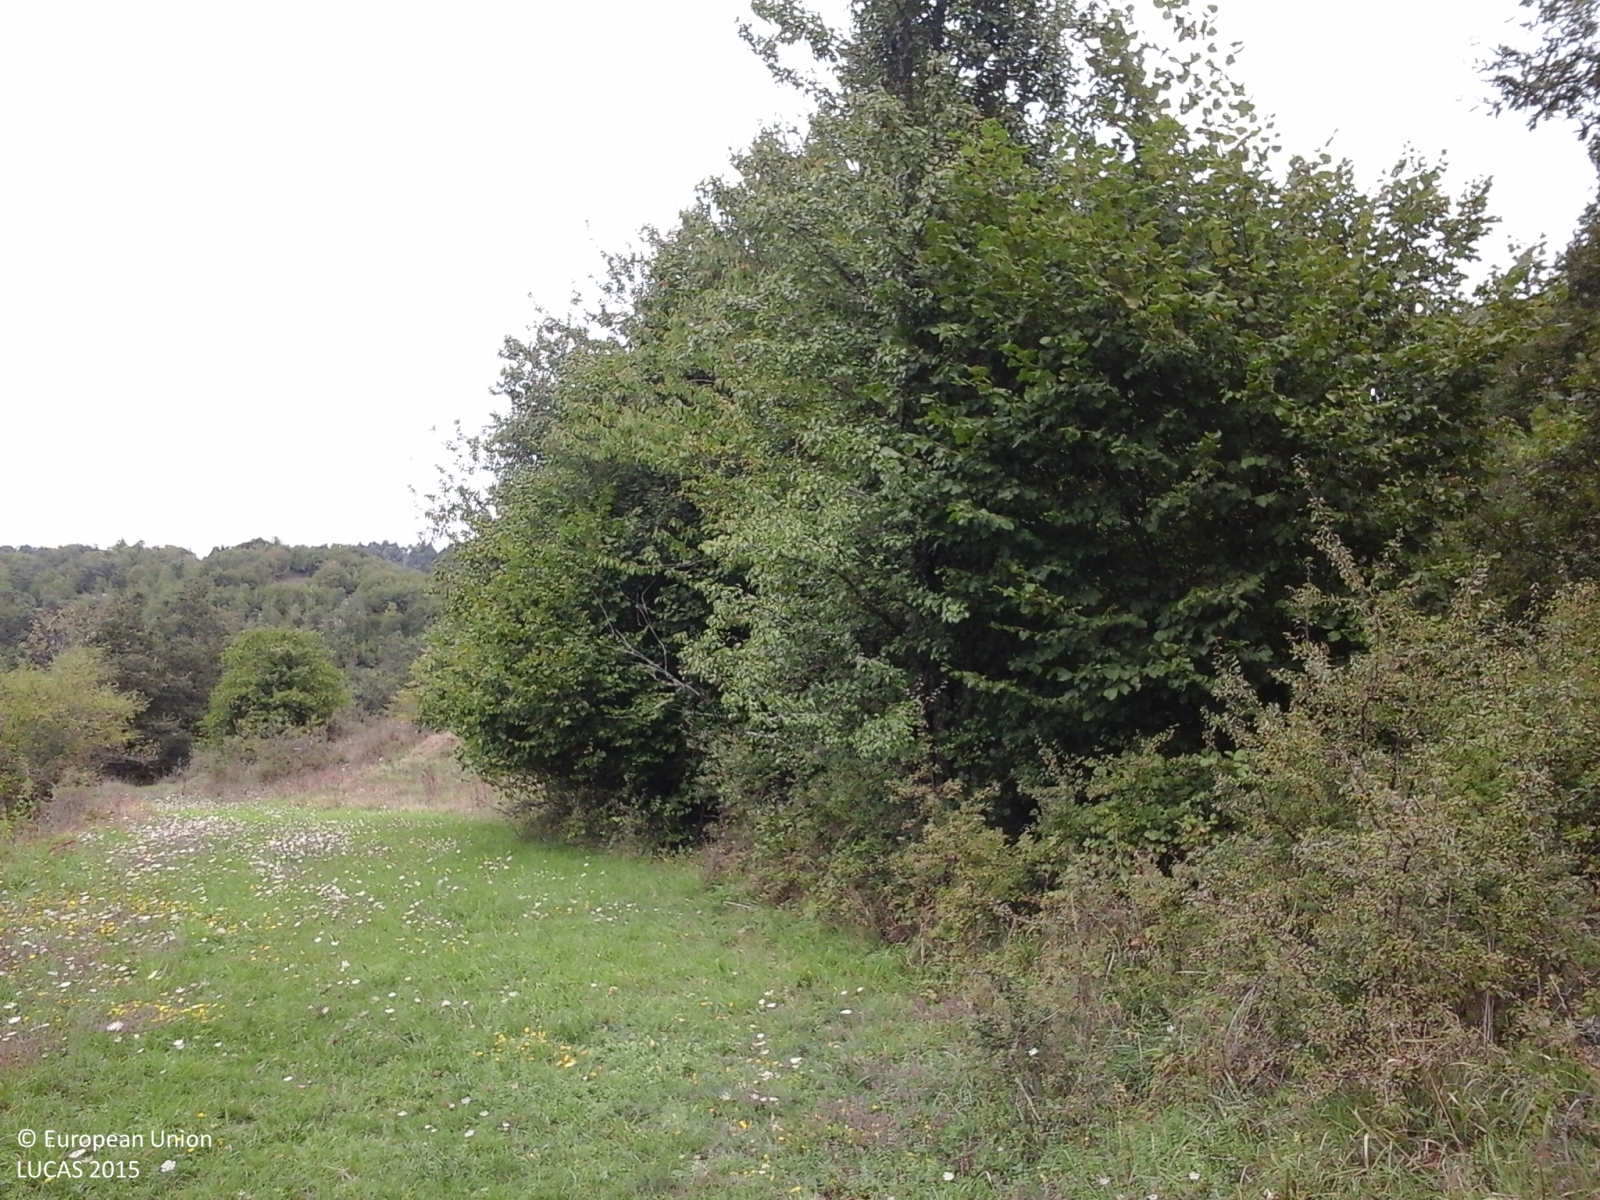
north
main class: Woodland
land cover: Broadleaved woodland
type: mesophytic deciduous forest
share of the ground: > 75 %
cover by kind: broadleaved forest trees 100 %
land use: Semi-natural and natural areas not in use
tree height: > 5 m
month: September
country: IT
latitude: 41.5278
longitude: 13.9522
